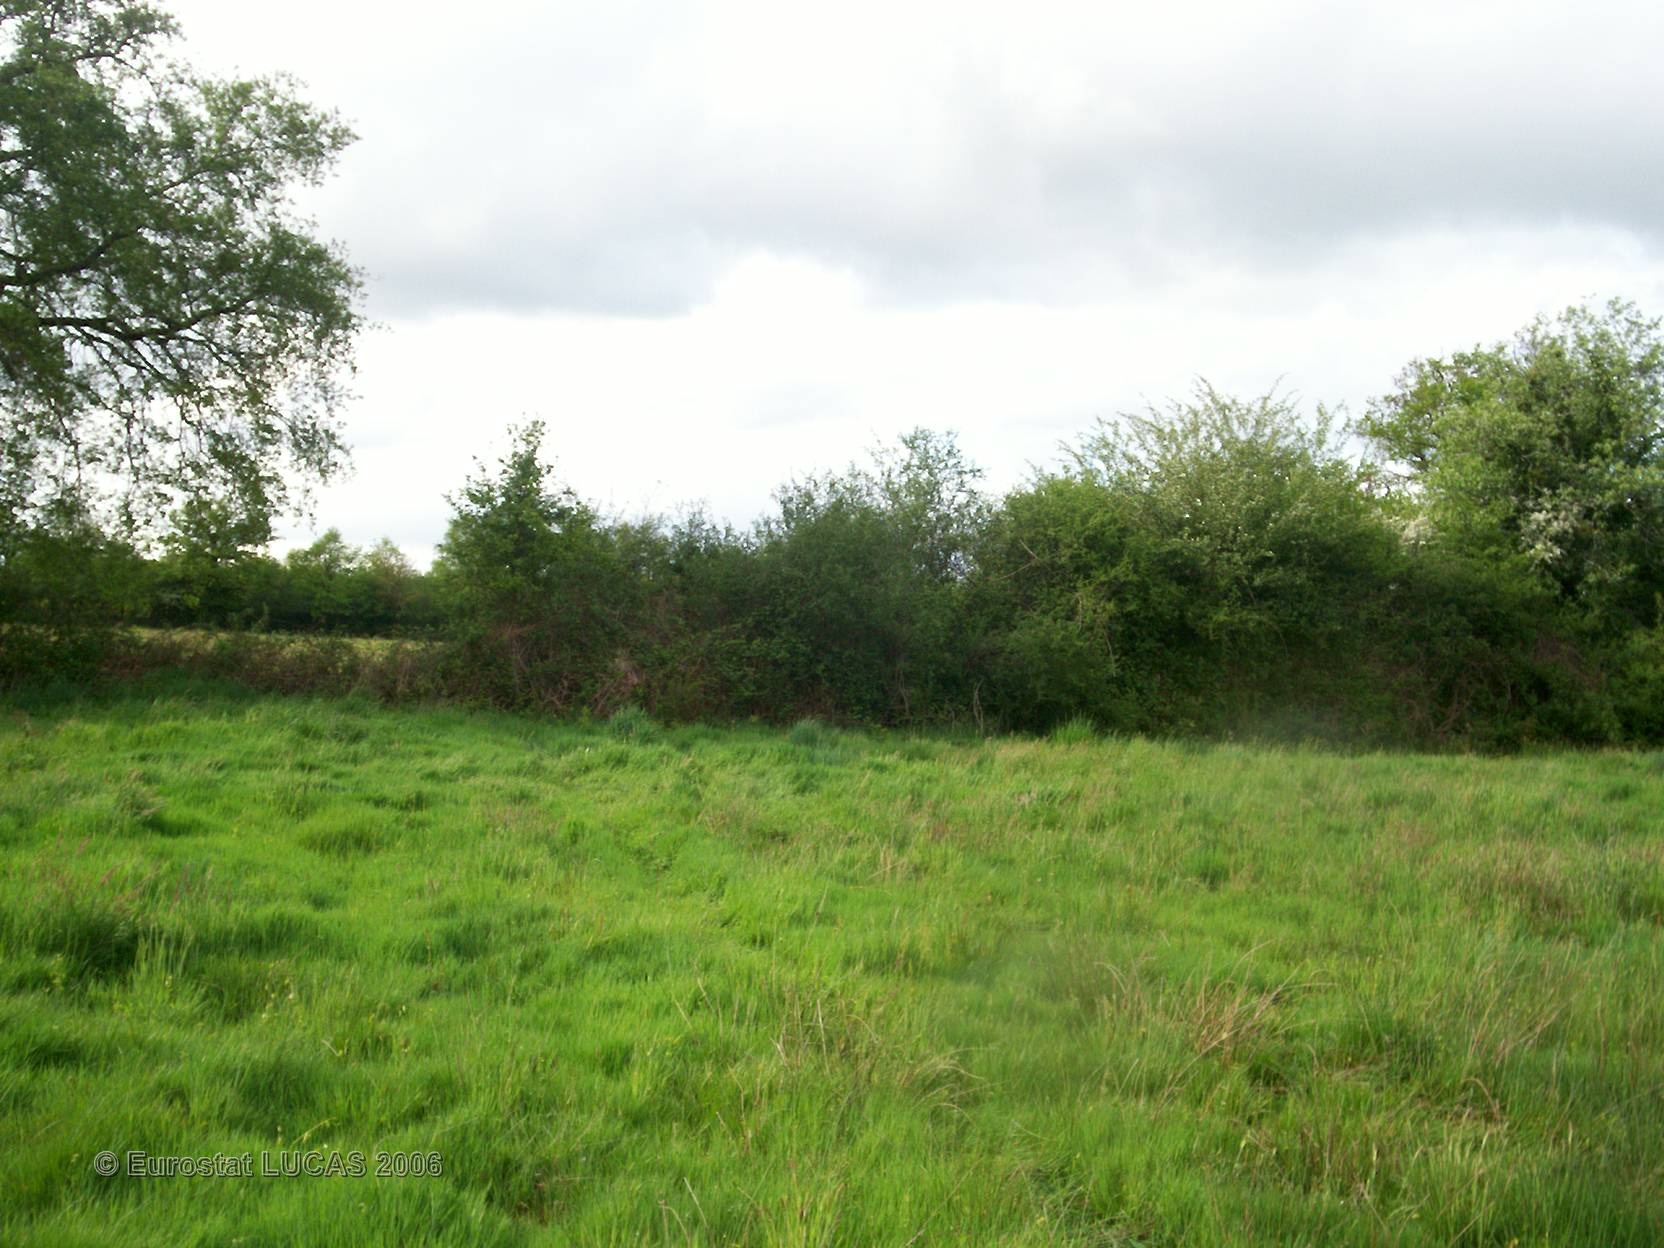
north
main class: Grassland
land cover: Grassland without tree/shrub cover
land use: Agriculture (excluding fallow land and kitchen gardens)
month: May
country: FR
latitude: 45.9304
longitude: 0.5323
